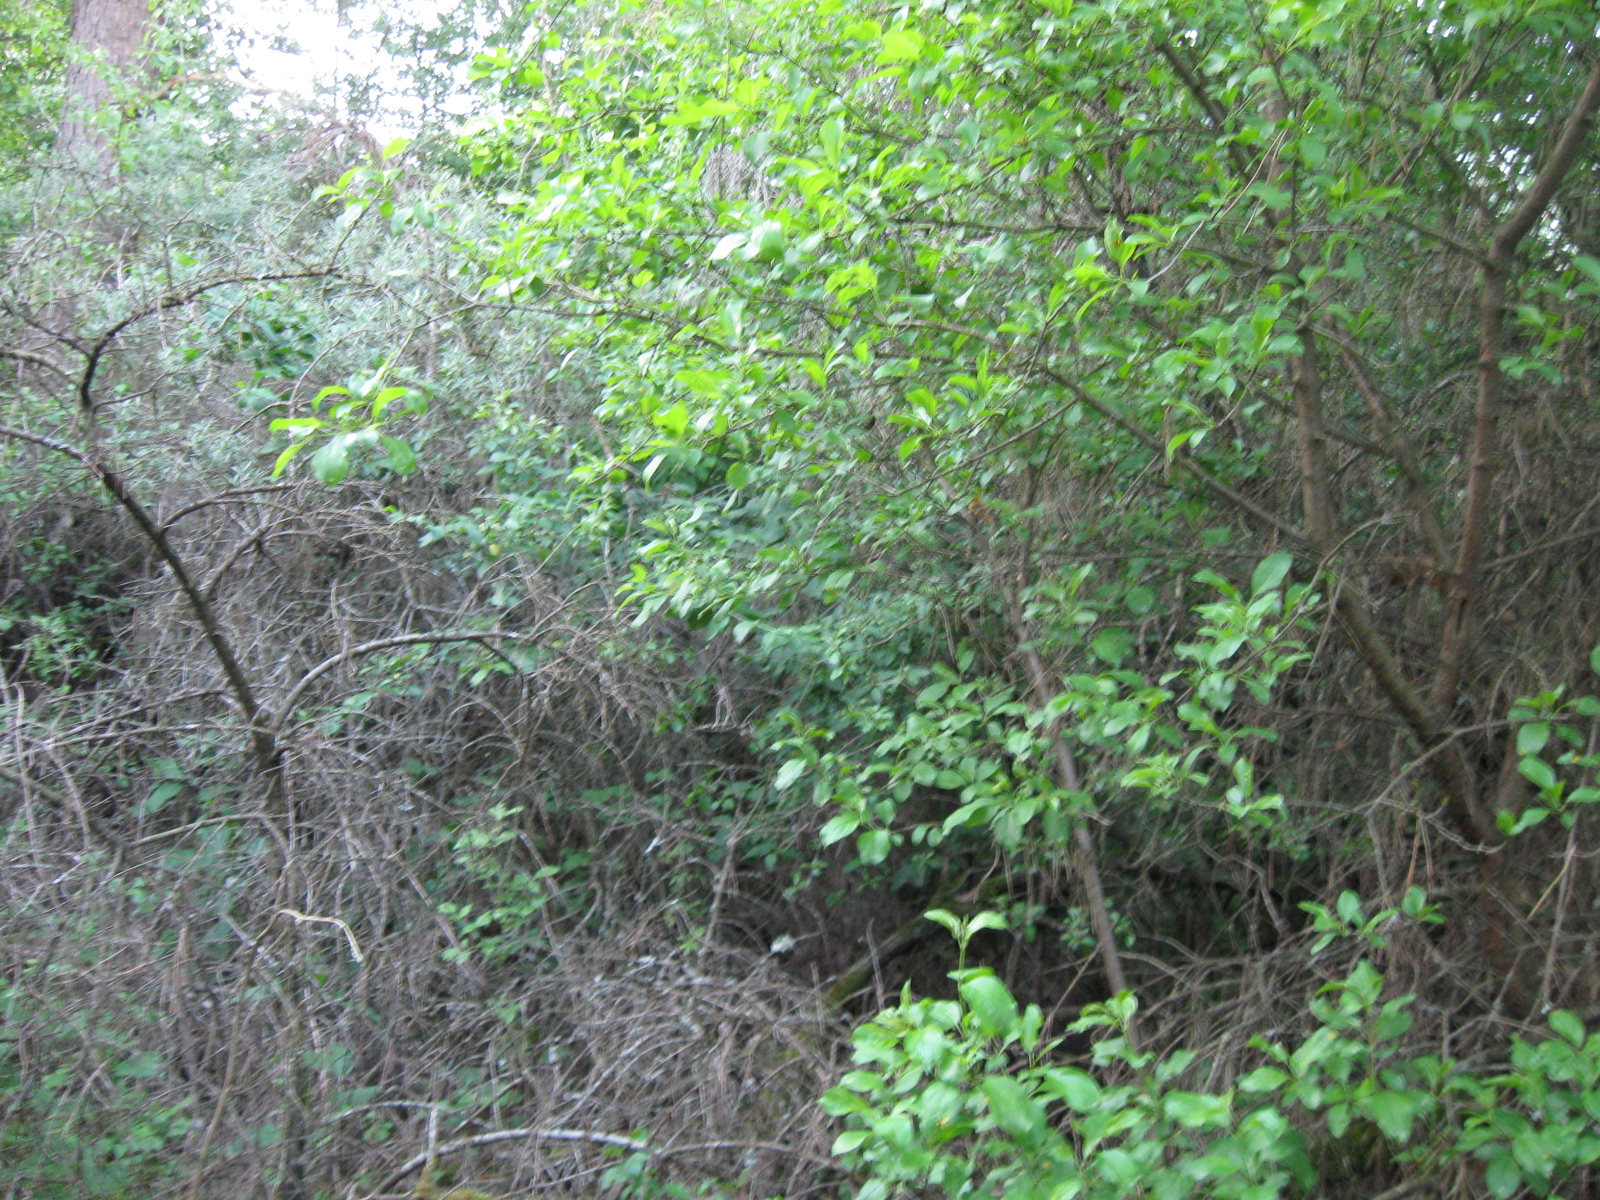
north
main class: Woodland
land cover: Other mixed woodland
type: hemiboreal forest and nemoral coniferous forest and mixed broadleaved-coniferous forest
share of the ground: > 75 %
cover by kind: broadleaved forest trees 70 %, coniferous forest trees 30 %
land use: Forestry
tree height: > 5 m
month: June
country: LT
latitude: 54.1660
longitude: 23.7344
